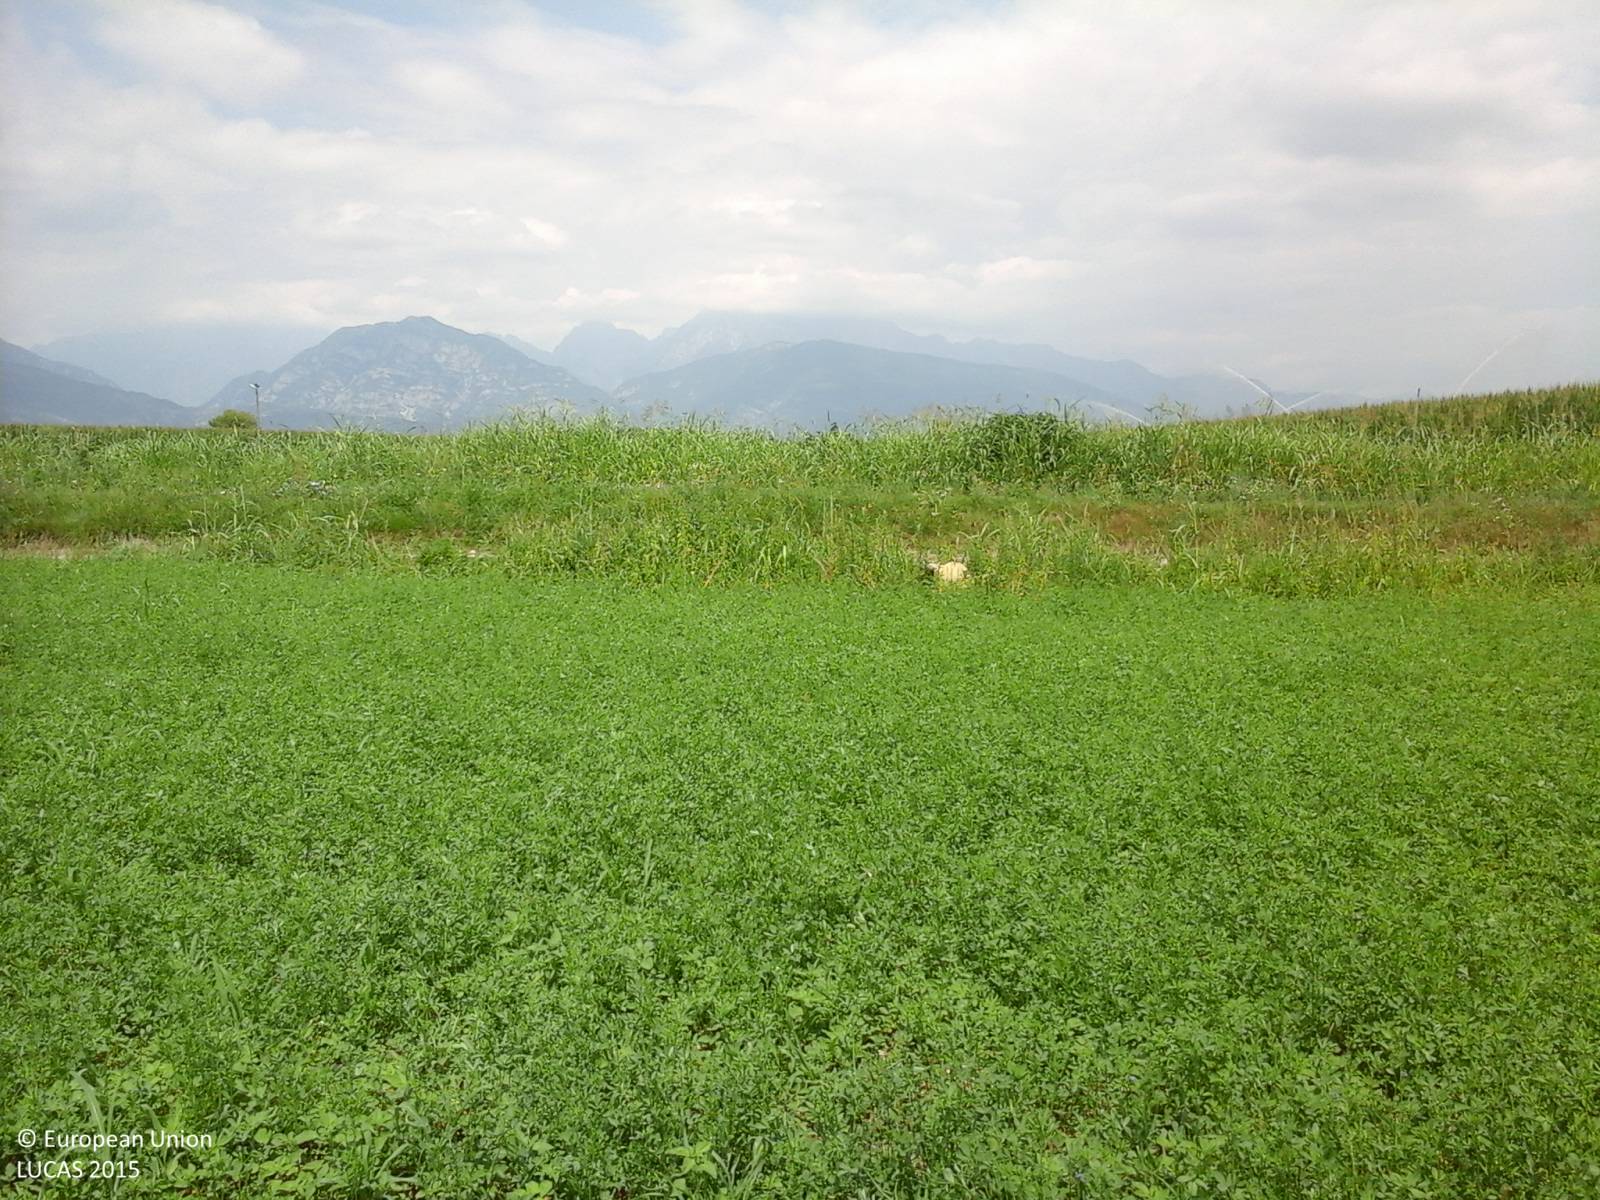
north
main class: Cropland
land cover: Lucerne
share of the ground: > 75 %
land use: Agriculture (excluding fallow land and kitchen gardens)
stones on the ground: 25 - 50 %
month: July
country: IT
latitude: 46.0829
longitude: 12.6995
